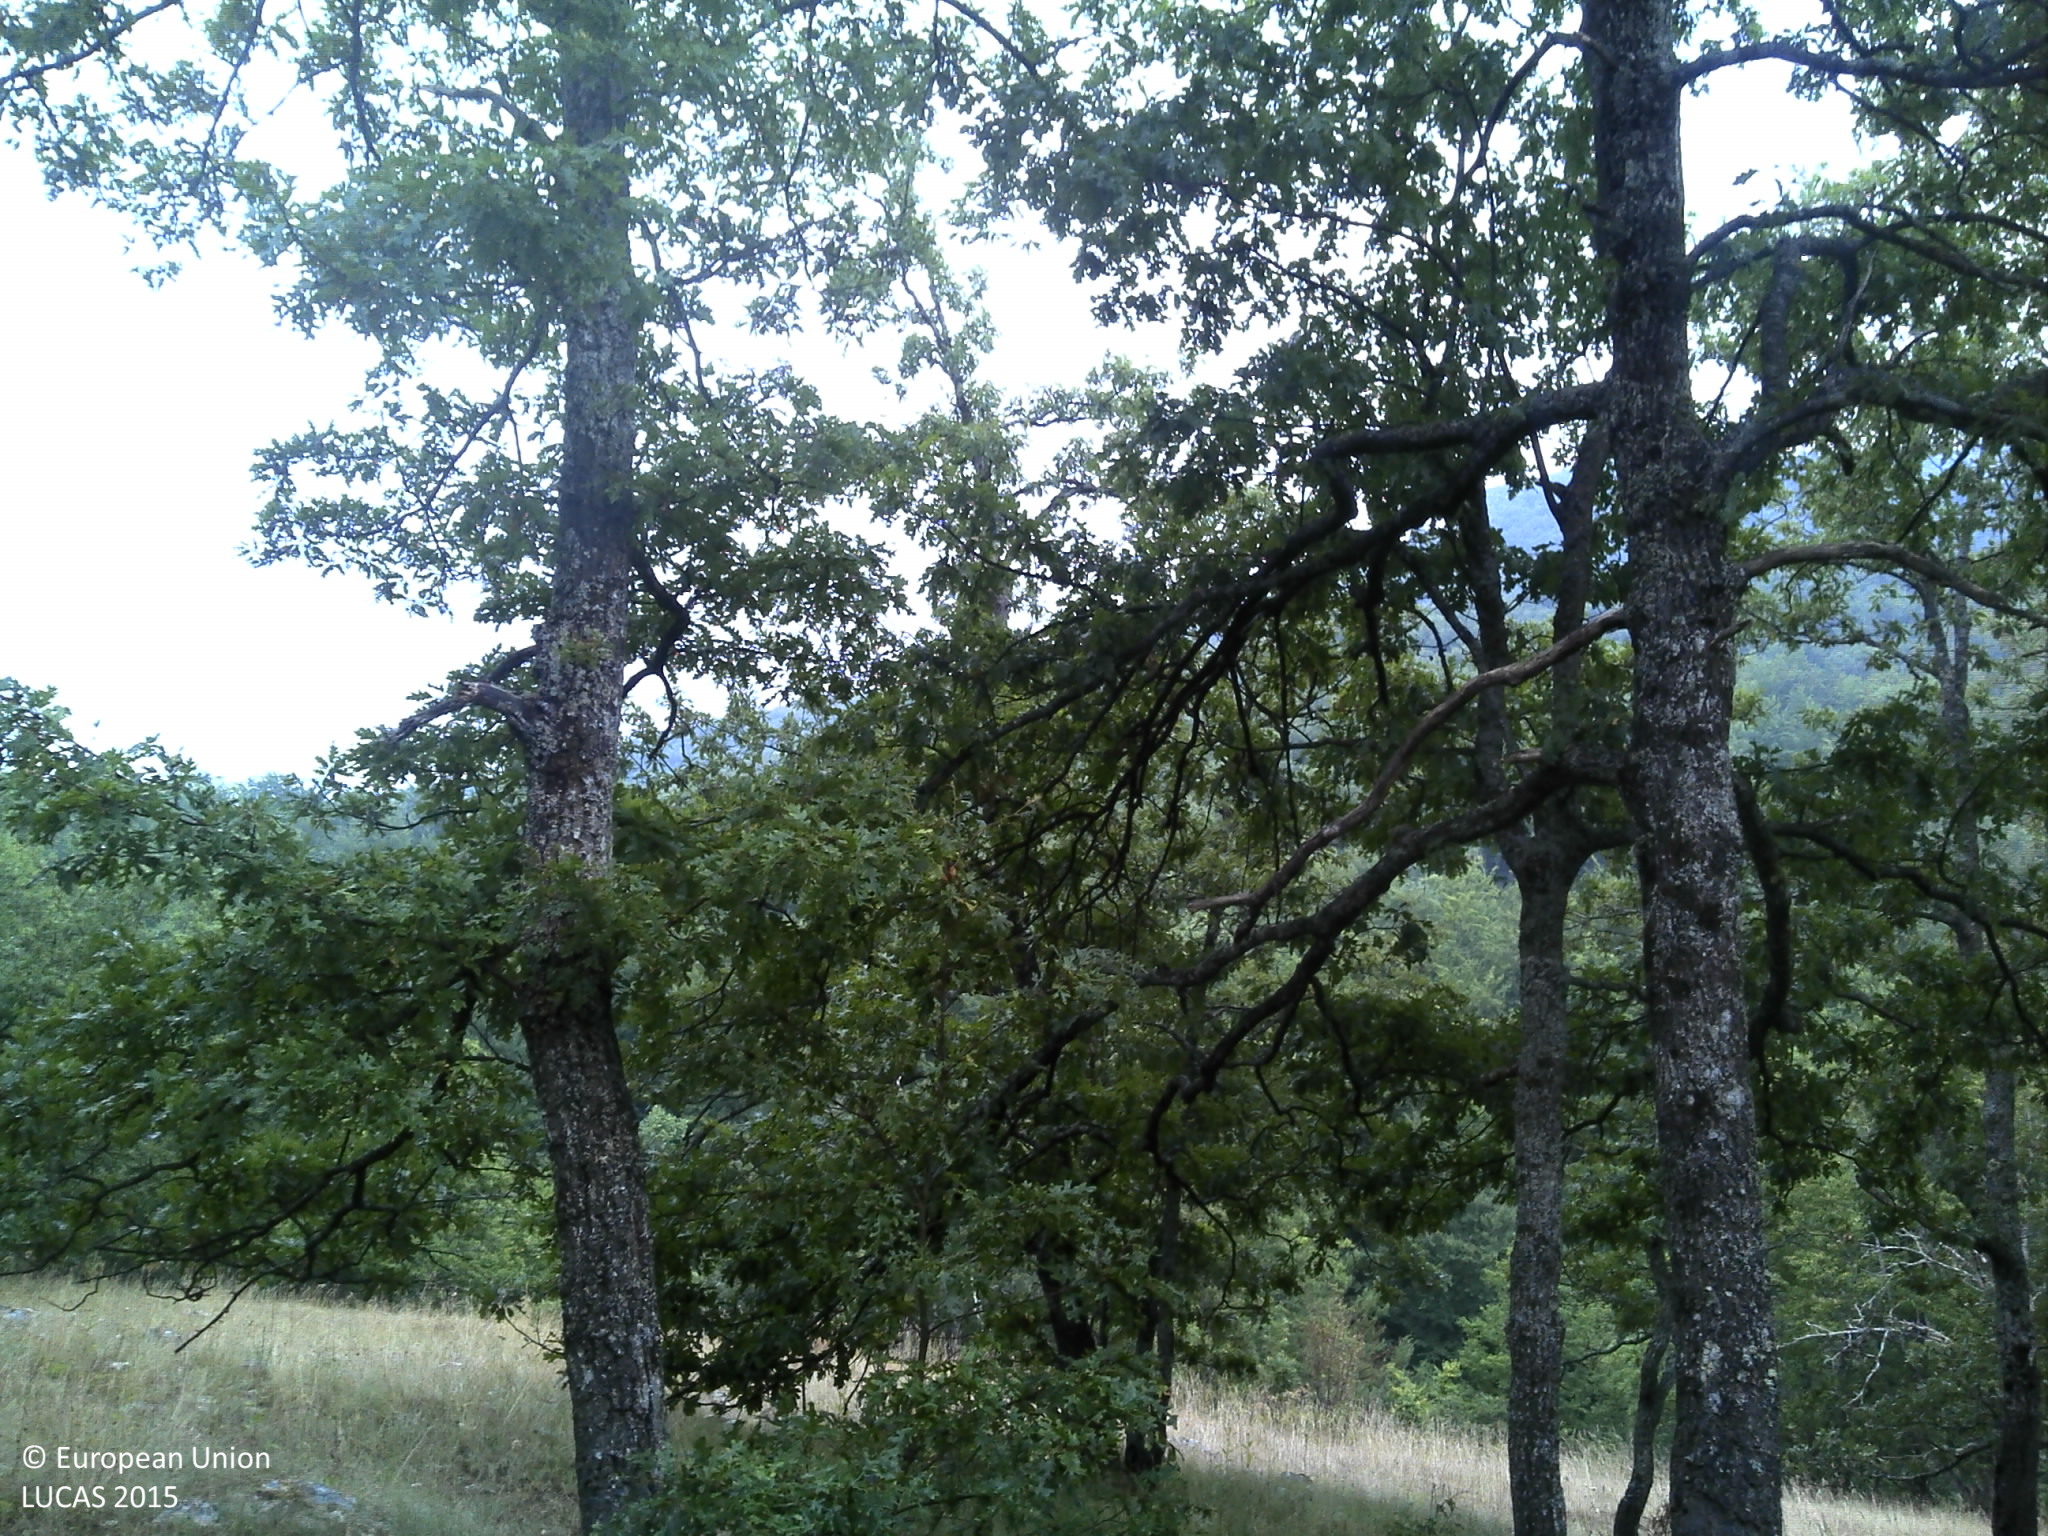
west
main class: Woodland
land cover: Broadleaved woodland
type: beech forest
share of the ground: 50 - 75 %
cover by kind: broadleaved forest trees 50 %, herbaceous plants 40 %, shrubs 10 %
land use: Semi-natural and natural areas not in use
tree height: > 5 m
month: July
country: HR
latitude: 44.4265
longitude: 16.0608
